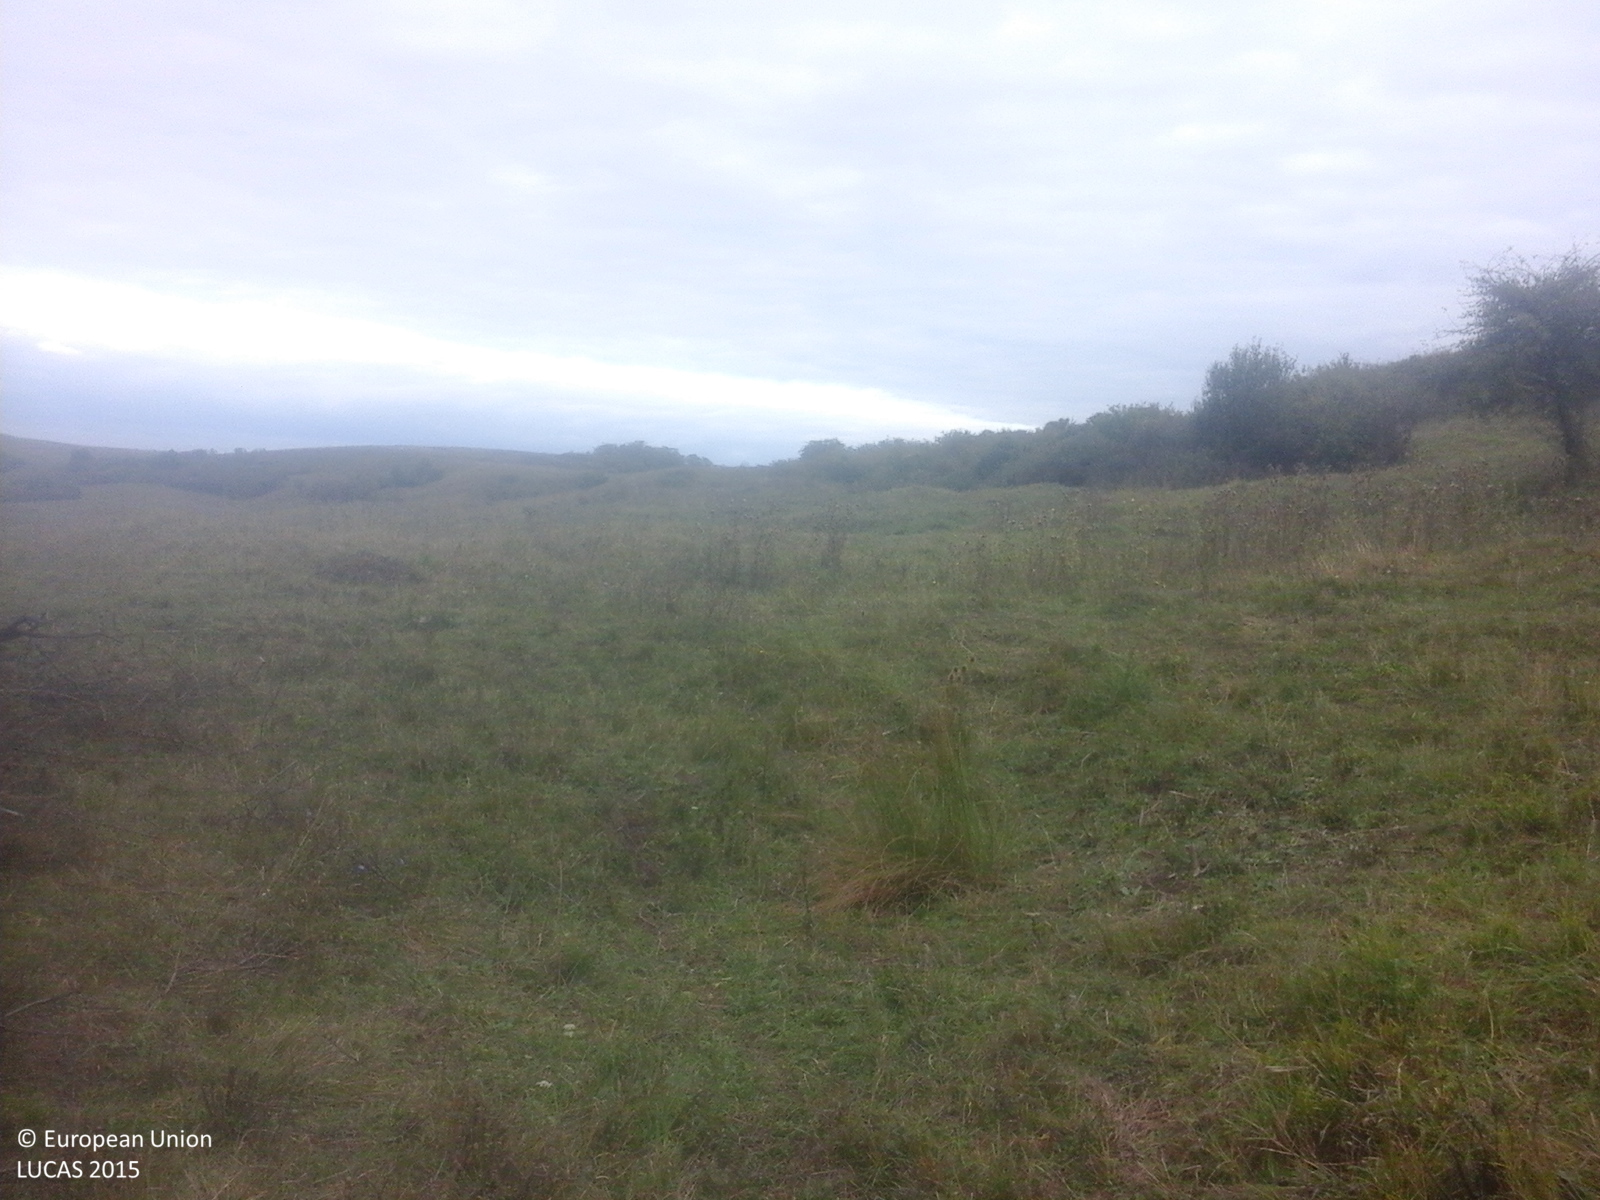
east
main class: Shrubland
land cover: Shrubland with sparse tree cover
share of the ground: > 75 %
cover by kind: shrubs 85 %, herbaceous plants 10 %, broadleaved forest trees 5 %
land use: Fallow land
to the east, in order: Shrubland with sparse tree cover; Grassland without tree/shrub cover; Grassland with sparse tree/shrub cover; Shrubland with sparse tree cover; Tracks; Grassland without tree/shrub cover; Grassland with sparse tree/shrub cover; Grassland without tree/shrub cover
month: September
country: RO
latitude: 45.9479
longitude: 23.9136
